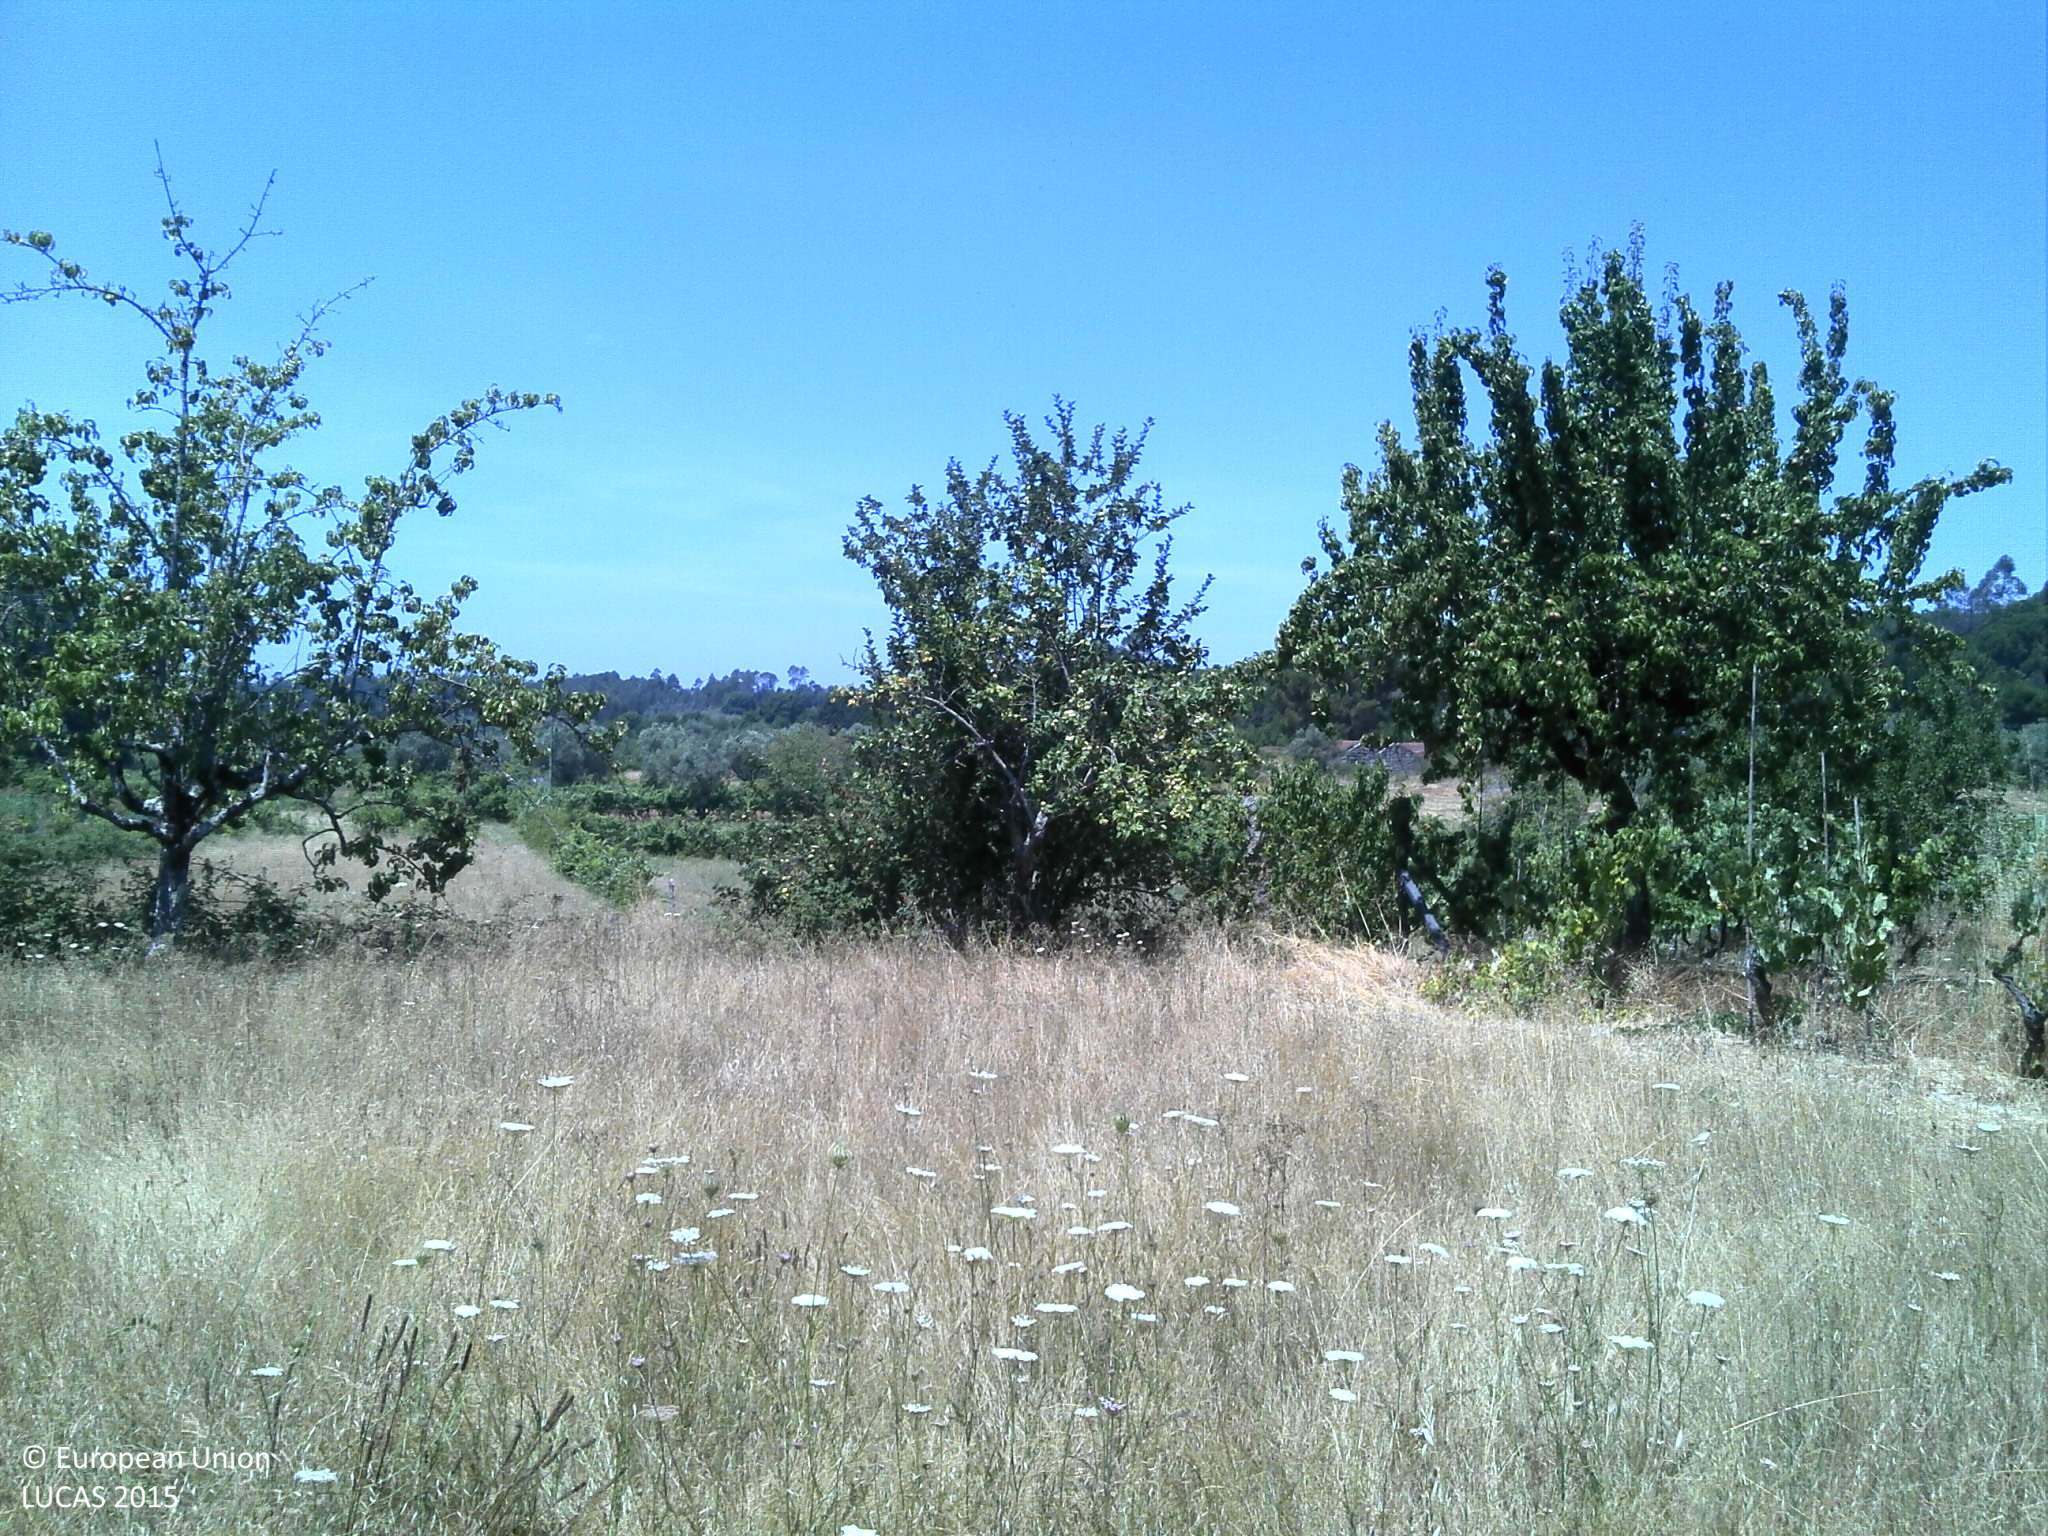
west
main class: Grassland
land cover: Grassland without tree/shrub cover
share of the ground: > 75 %
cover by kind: herbaceous plants 80 %, unconsolidated bare surface 20 %
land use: Agriculture (excluding fallow land and kitchen gardens)
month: July
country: PT
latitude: 40.4730
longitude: -7.9928
